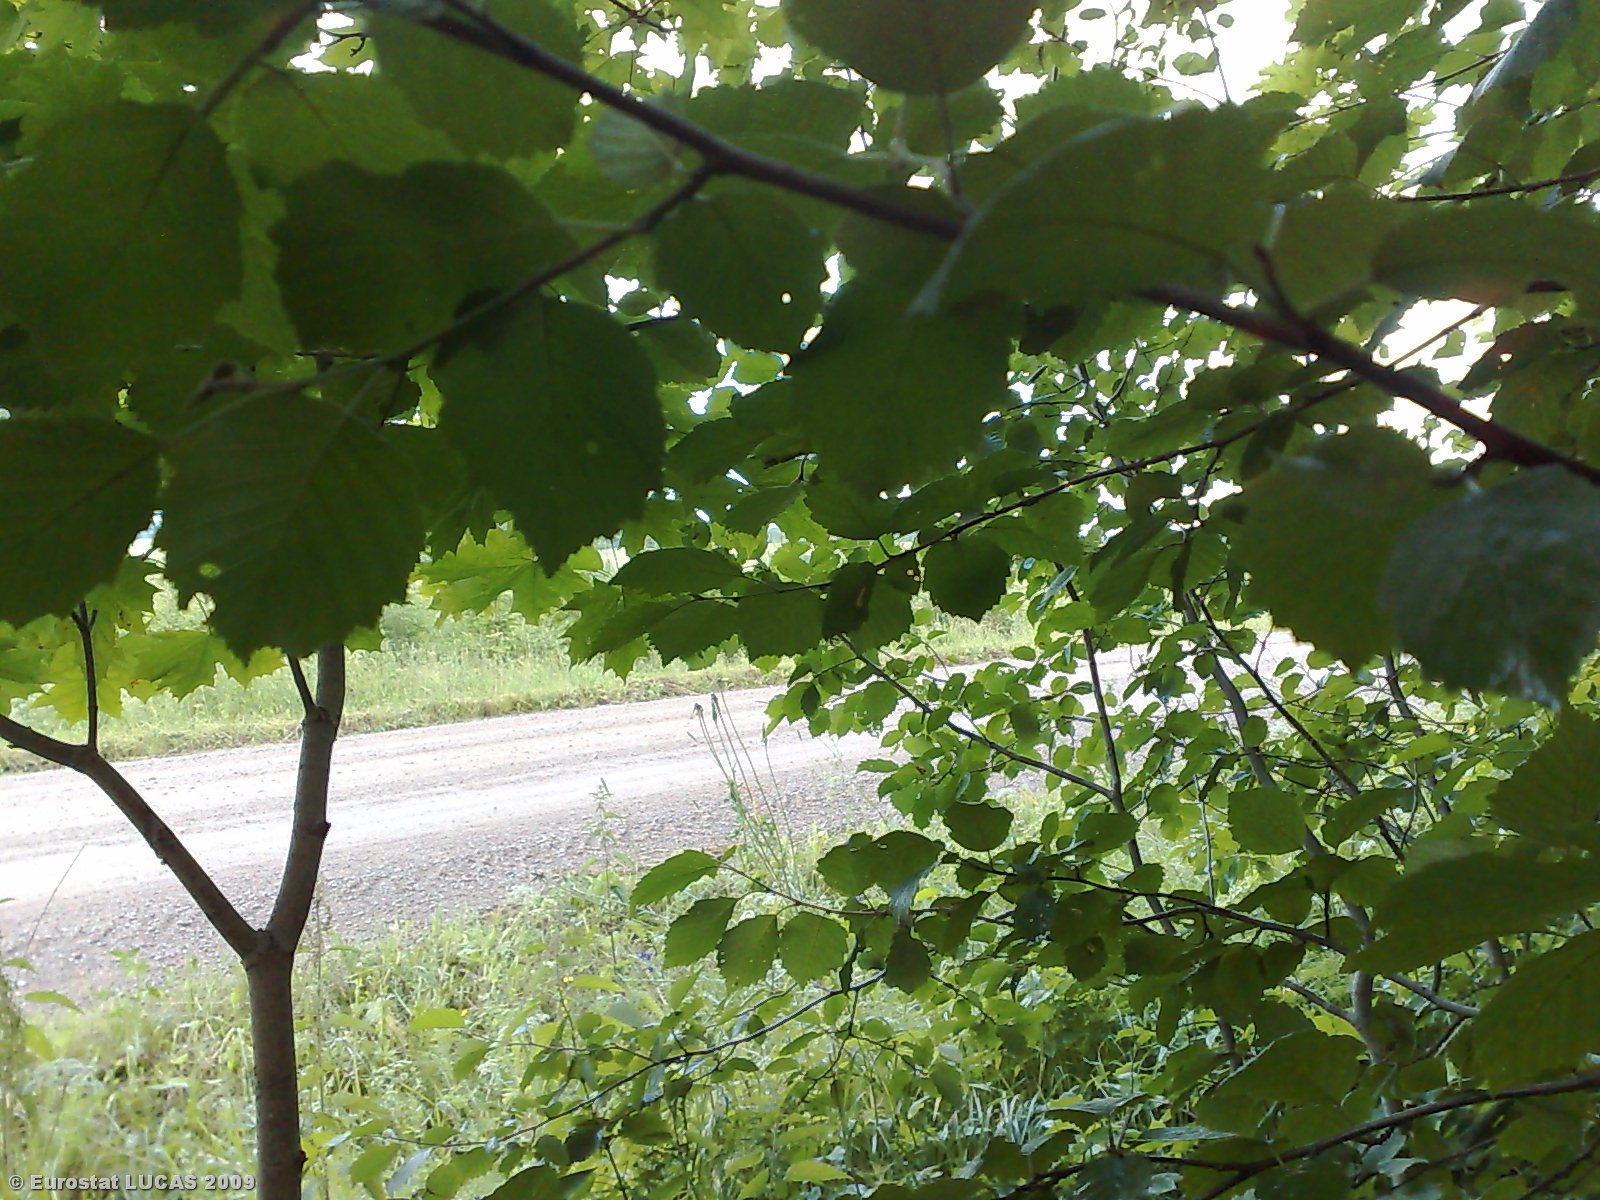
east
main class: Woodland
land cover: Broadleaved woodland
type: non-riverine alder, birch or aspen forest
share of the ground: > 75 %
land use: Forestry
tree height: > 5 m
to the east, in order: Broadleaved woodland; Grass margins; Paved roads, cycling and walking lanes; Grassland without tree/shrub cover; Coniferous woodland; Grassland without tree/shrub cover; Inland water bodies; Grassland without tree/shrub cover
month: July
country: LT
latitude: 55.6563
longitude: 22.7641
